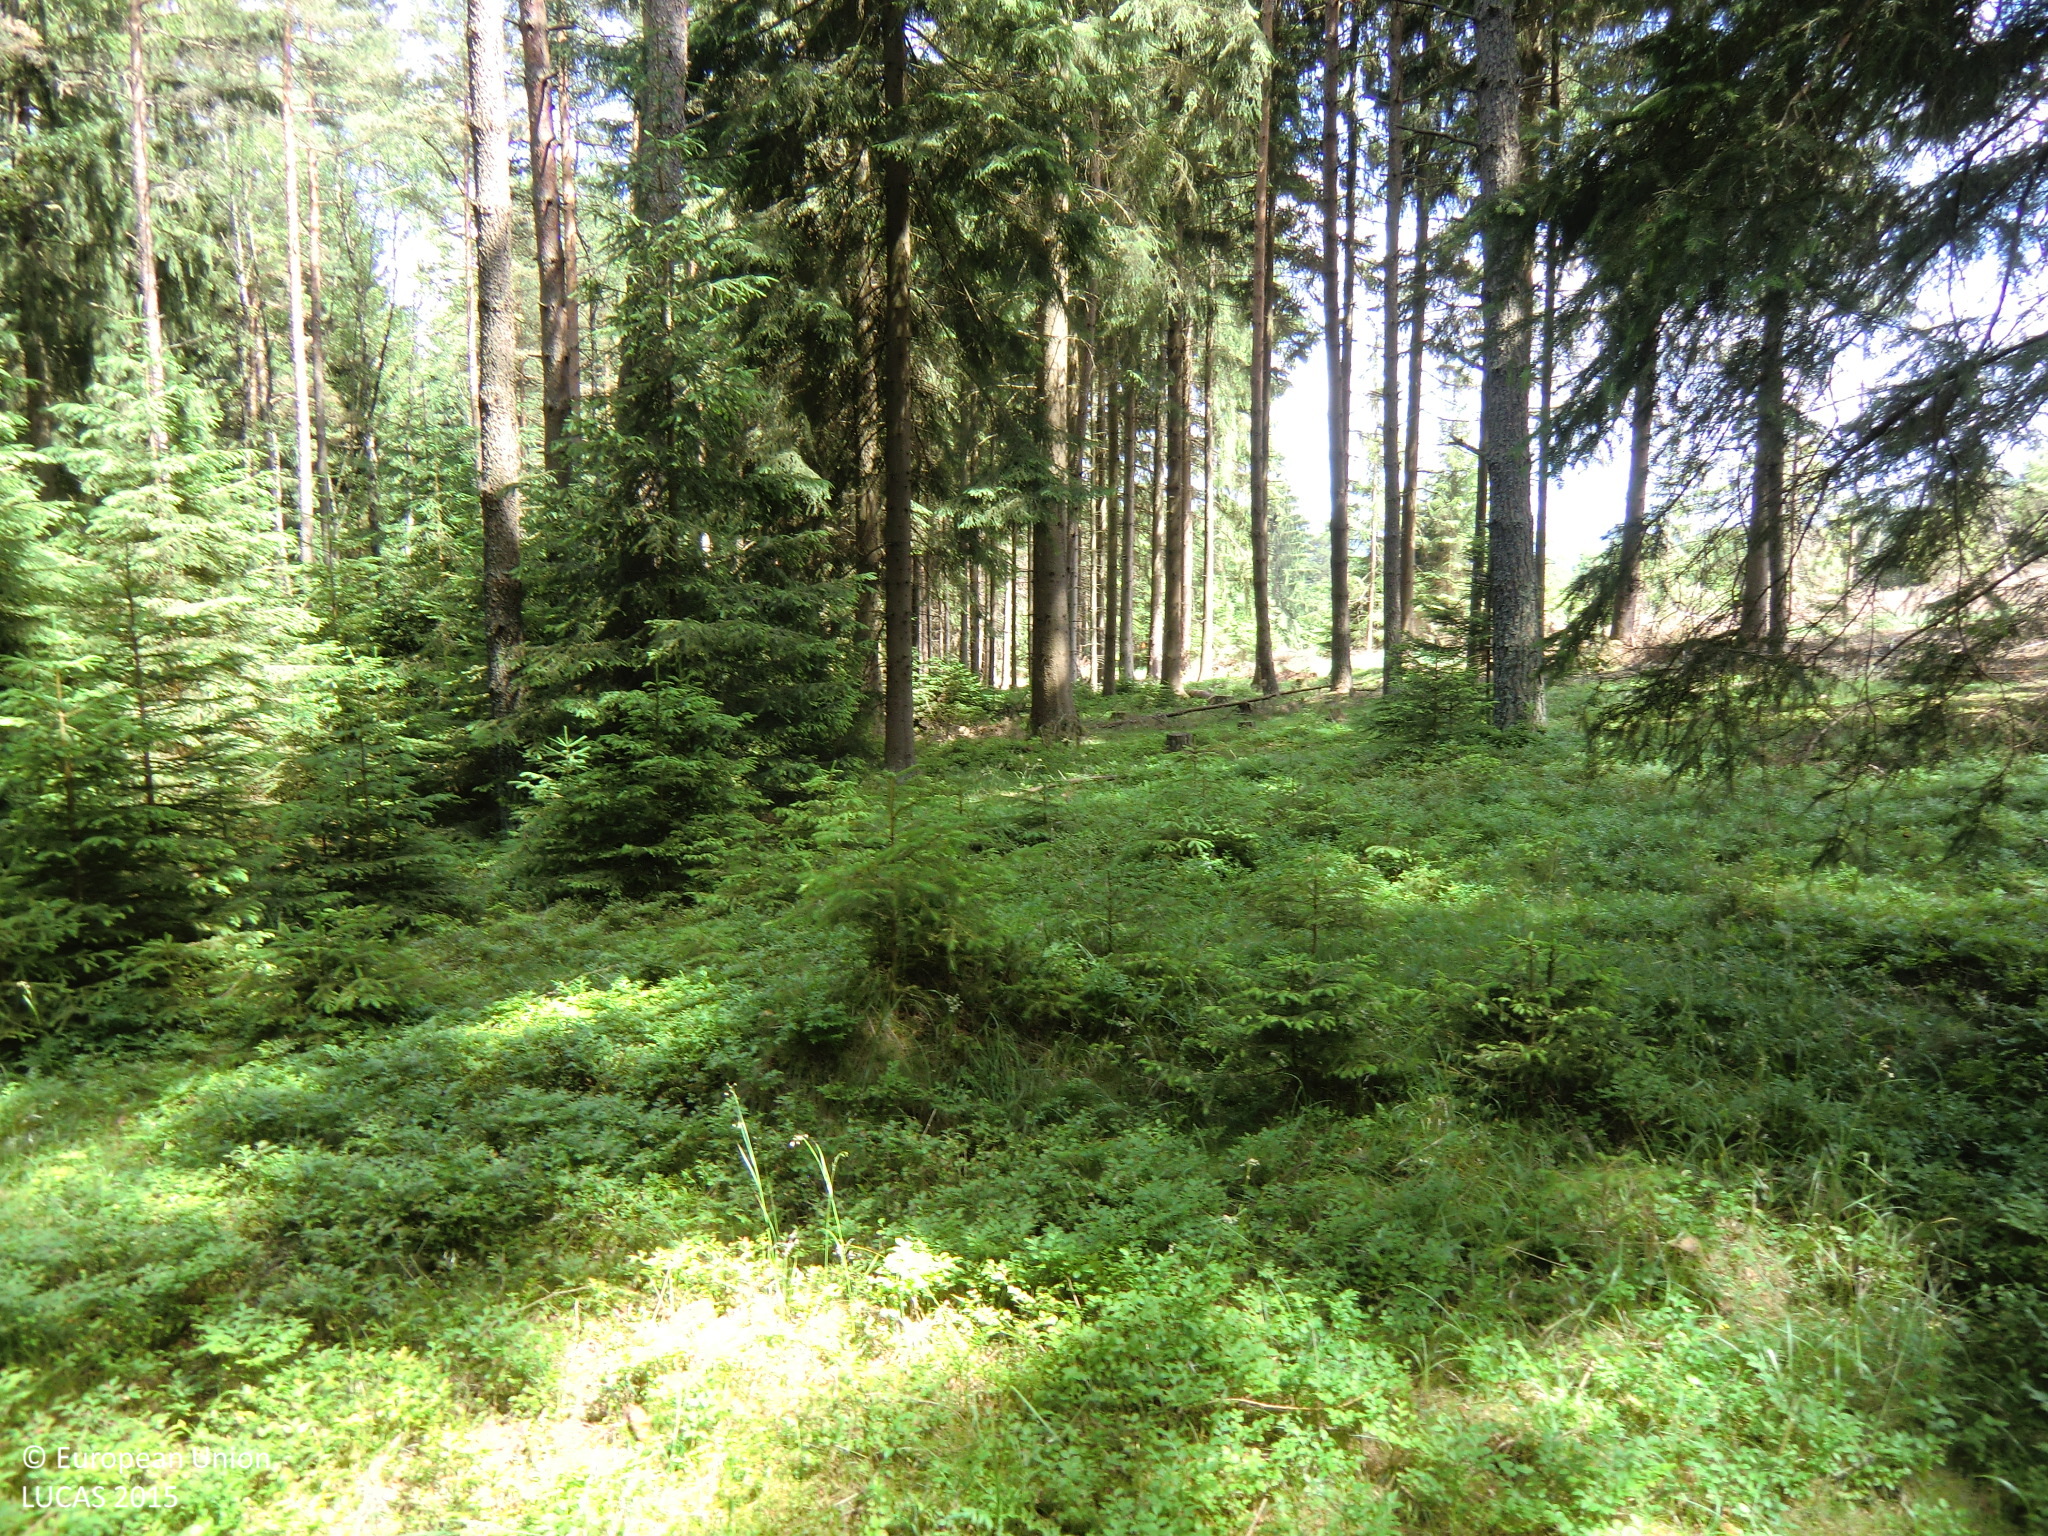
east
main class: Woodland
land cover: Spruce dominated coniferous woodland
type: hemiboreal forest and nemoral coniferous forest and mixed broadleaved-coniferous forest
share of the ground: > 75 %
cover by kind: coniferous forest trees 75 %, shrubs 20 %, herbaceous plants 5 %
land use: Forestry
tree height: > 5 m
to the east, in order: Spruce dominated coniferous woodland; Tracks; Spruce dominated mixed woodland; Rivers and streams; Tracks; Spruce dominated coniferous woodland
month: June
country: AT
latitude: 48.5236
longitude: 15.0250
